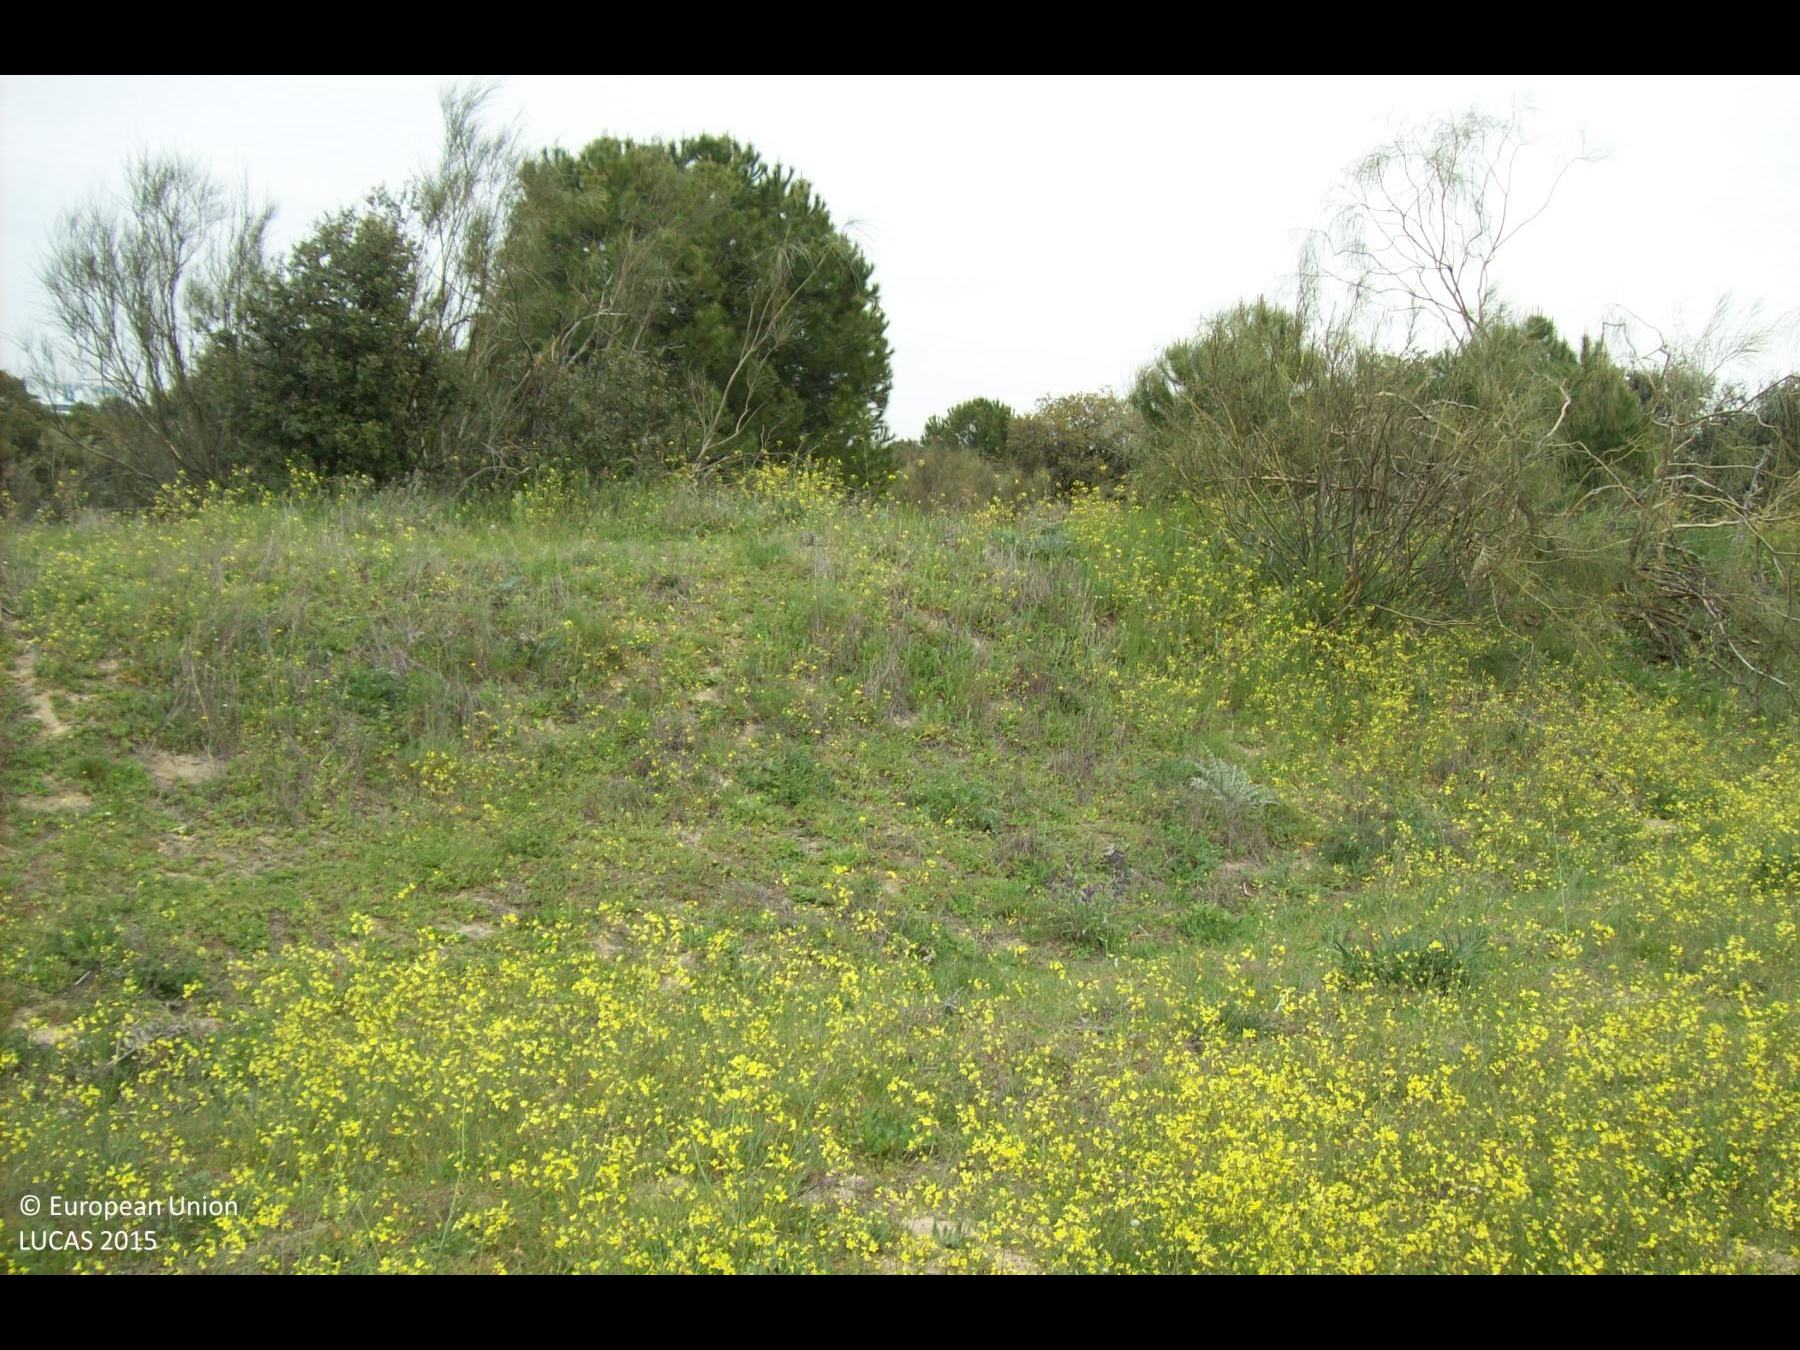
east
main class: Grassland
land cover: Grassland with sparse tree/shrub cover
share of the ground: > 75 %
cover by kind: herbaceous plants 85 %, shrubs 10 %, broadleaved forest trees 5 %
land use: Semi-natural and natural areas not in use
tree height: < 5 m
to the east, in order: Grassland with sparse tree/shrub cover; Broadleaved woodland; Tracks; Grassland with sparse tree/shrub cover; Tracks; Broadleaved woodland; Tracks; Grassland with sparse tree/shrub cover; Paved roads, cycling and walking lanes; Grass margins; Ditches and canals; Grass margins
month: April
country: ES
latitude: 40.4350
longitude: -3.8439
